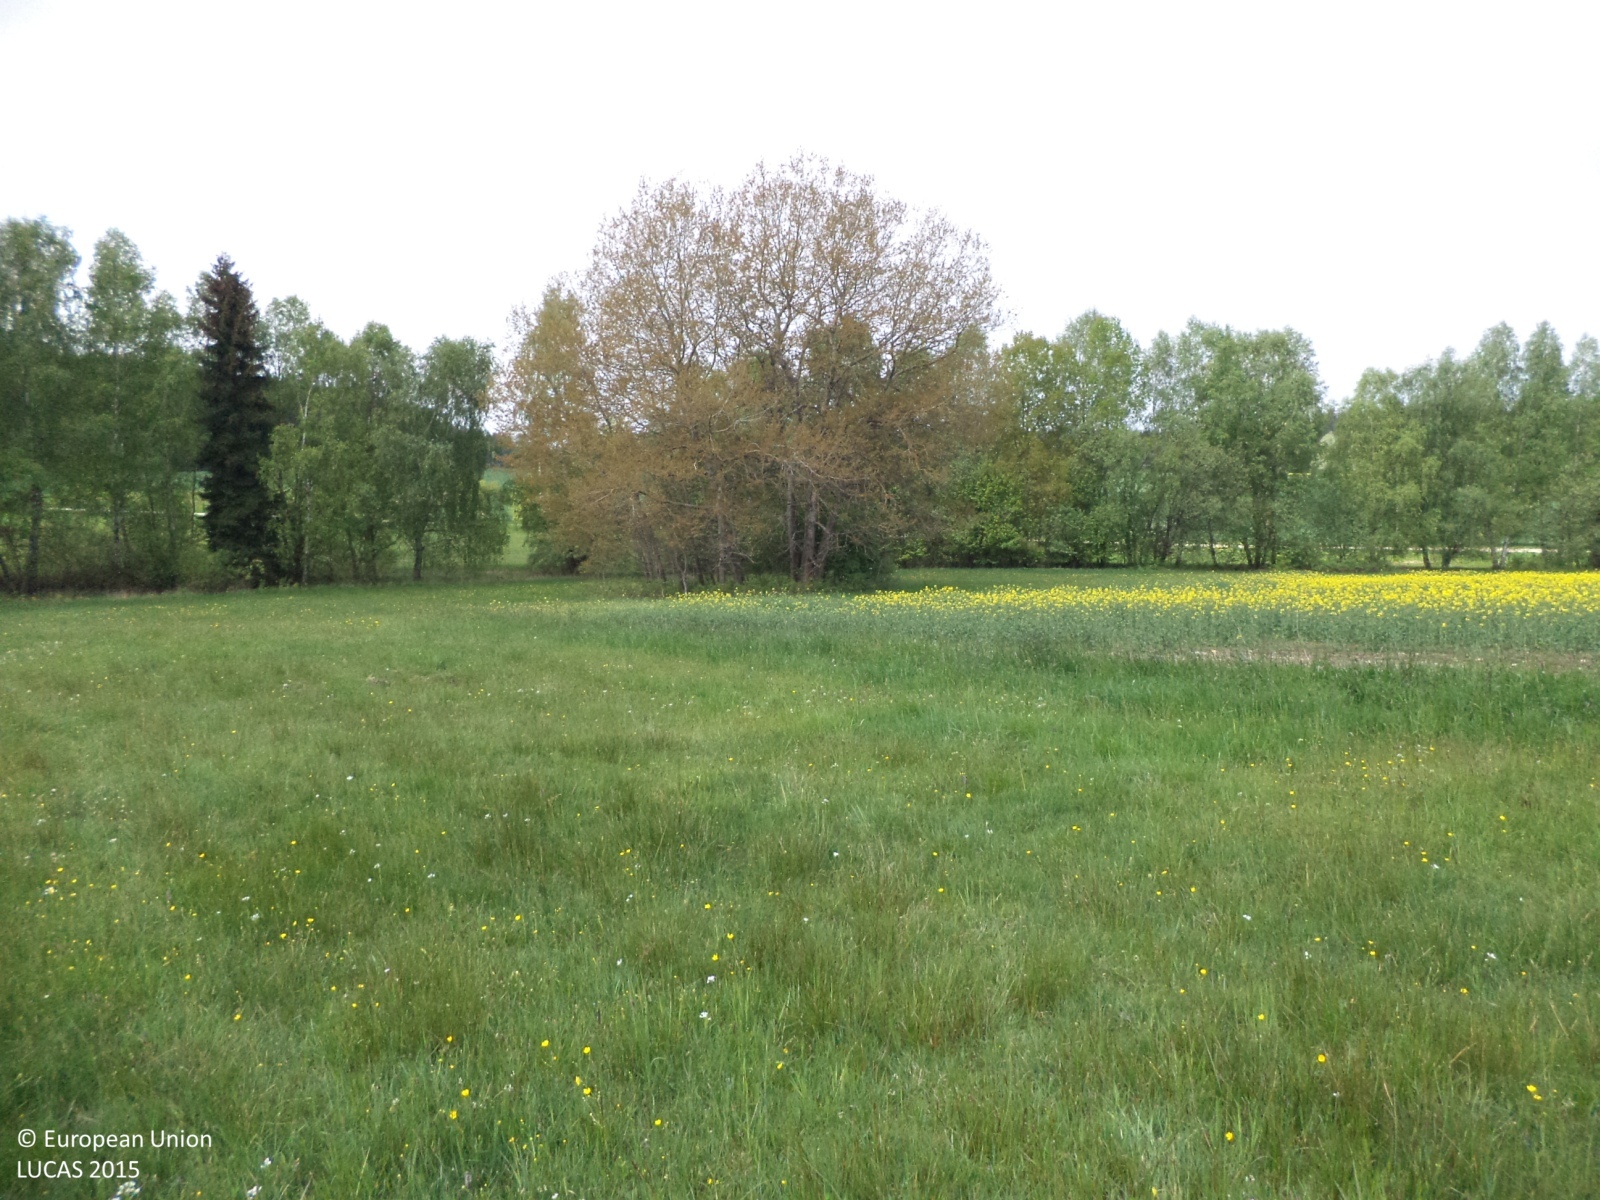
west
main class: Grassland
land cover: Grassland without tree/shrub cover
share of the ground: > 75 %
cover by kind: herbaceous plants 100 %
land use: Agriculture (excluding fallow land and kitchen gardens)
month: May
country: CZ
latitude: 49.3681
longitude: 15.0840
